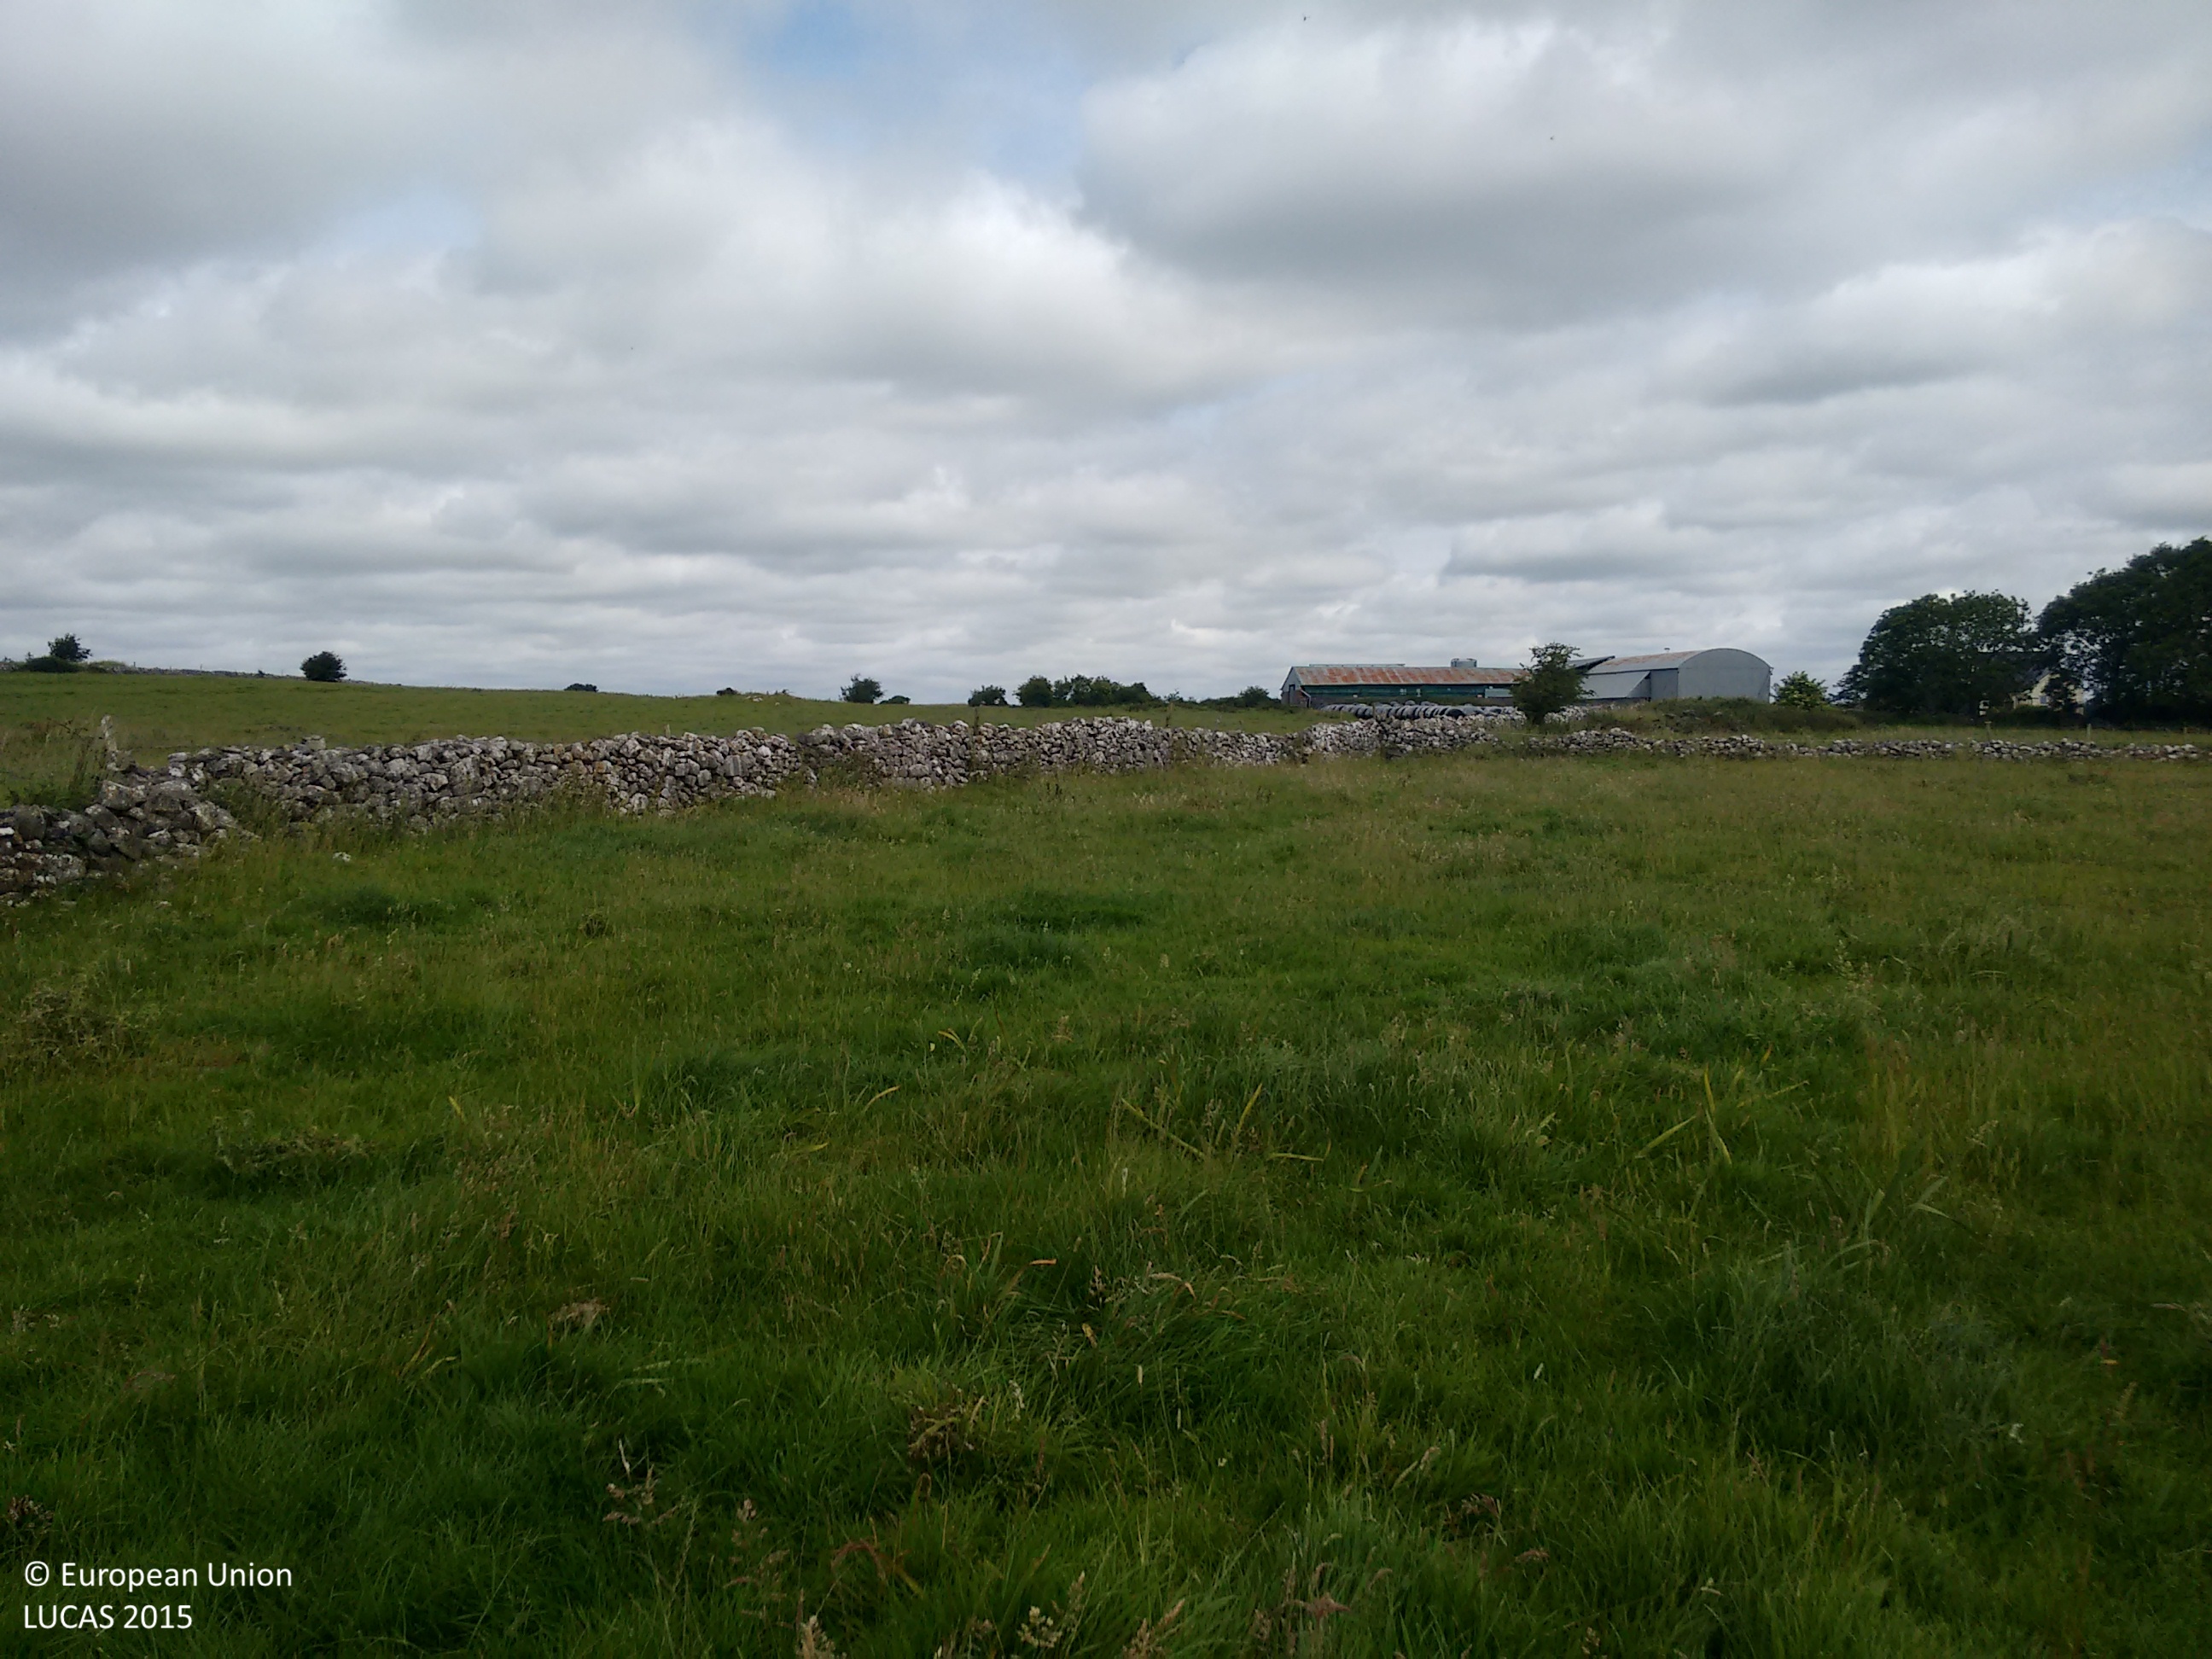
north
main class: Grassland
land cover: Grassland without tree/shrub cover
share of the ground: > 75 %
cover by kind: herbaceous plants 100 %
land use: Agriculture (excluding fallow land and kitchen gardens)
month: July
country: IE
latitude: 53.7397
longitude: -8.2088
